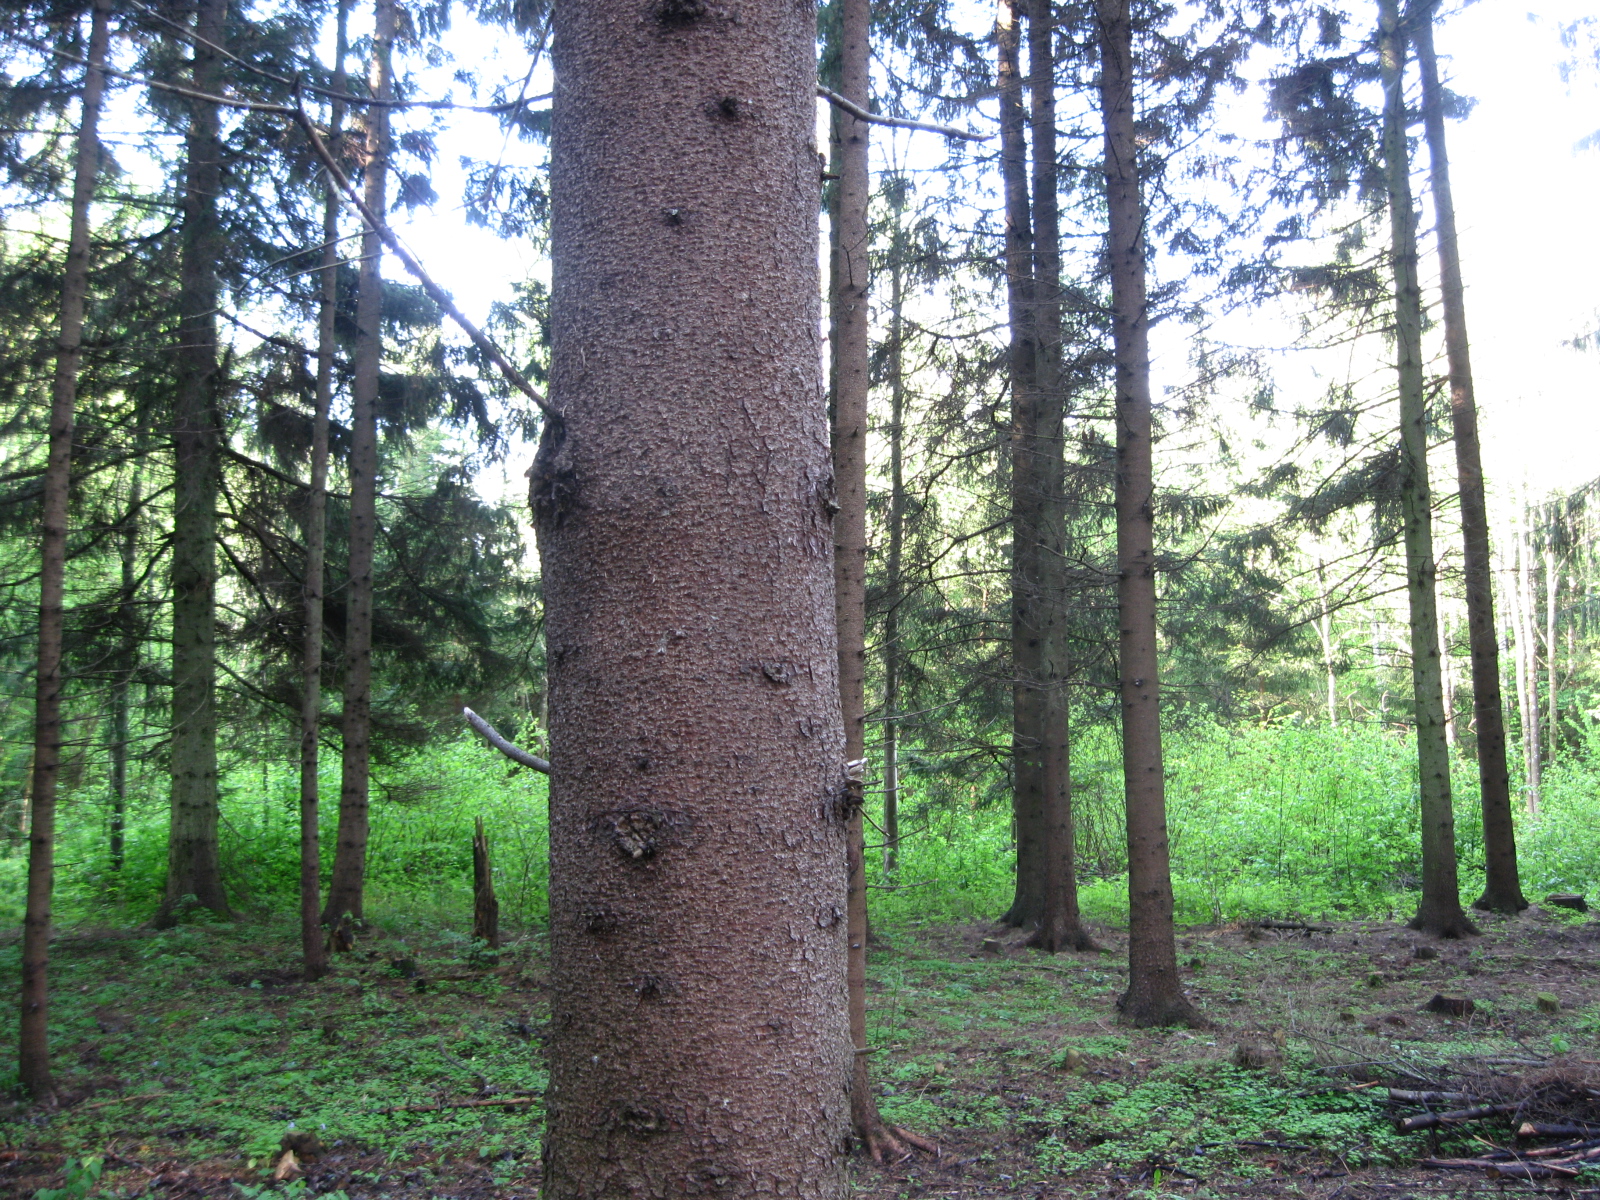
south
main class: Woodland
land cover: Spruce dominated coniferous woodland
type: hemiboreal forest and nemoral coniferous forest and mixed broadleaved-coniferous forest
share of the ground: > 75 %
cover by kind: coniferous forest trees 80 %, herbaceous plants 10 %, broadleaved forest trees 5 %, shrubs 5 %
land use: Forestry
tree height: > 5 m
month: May
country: LT
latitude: 56.3280
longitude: 24.0103
